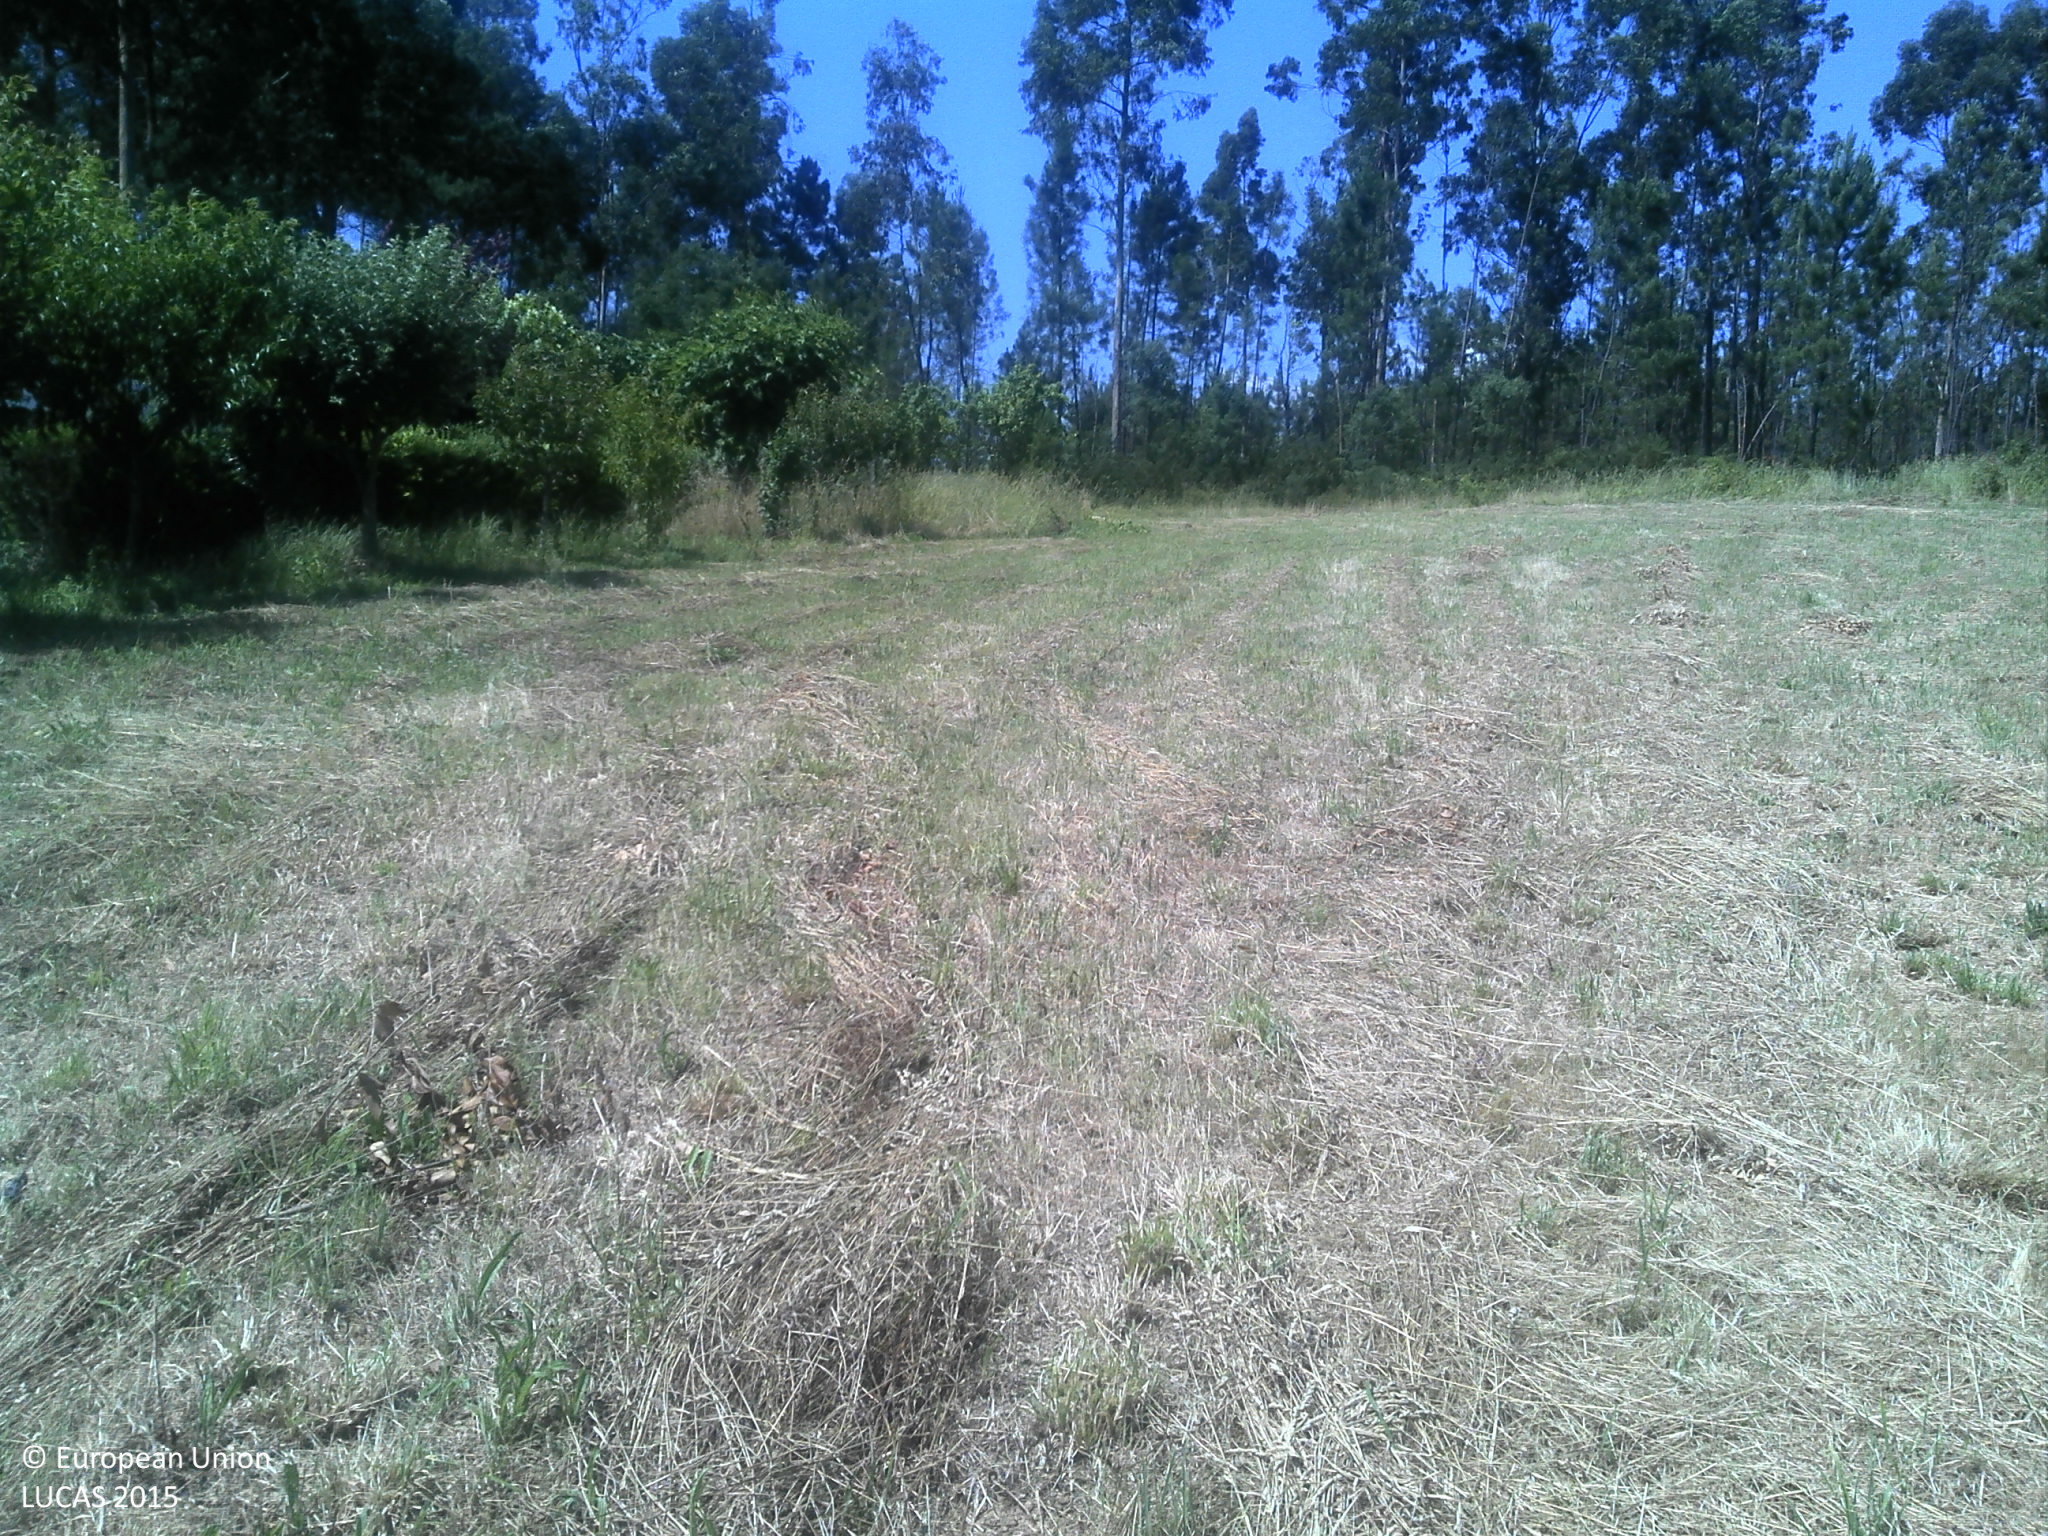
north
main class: Cropland
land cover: Temporary grasslands
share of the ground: > 75 %
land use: Agriculture (excluding fallow land and kitchen gardens)
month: June
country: PT
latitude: 41.5361
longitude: -8.5315
